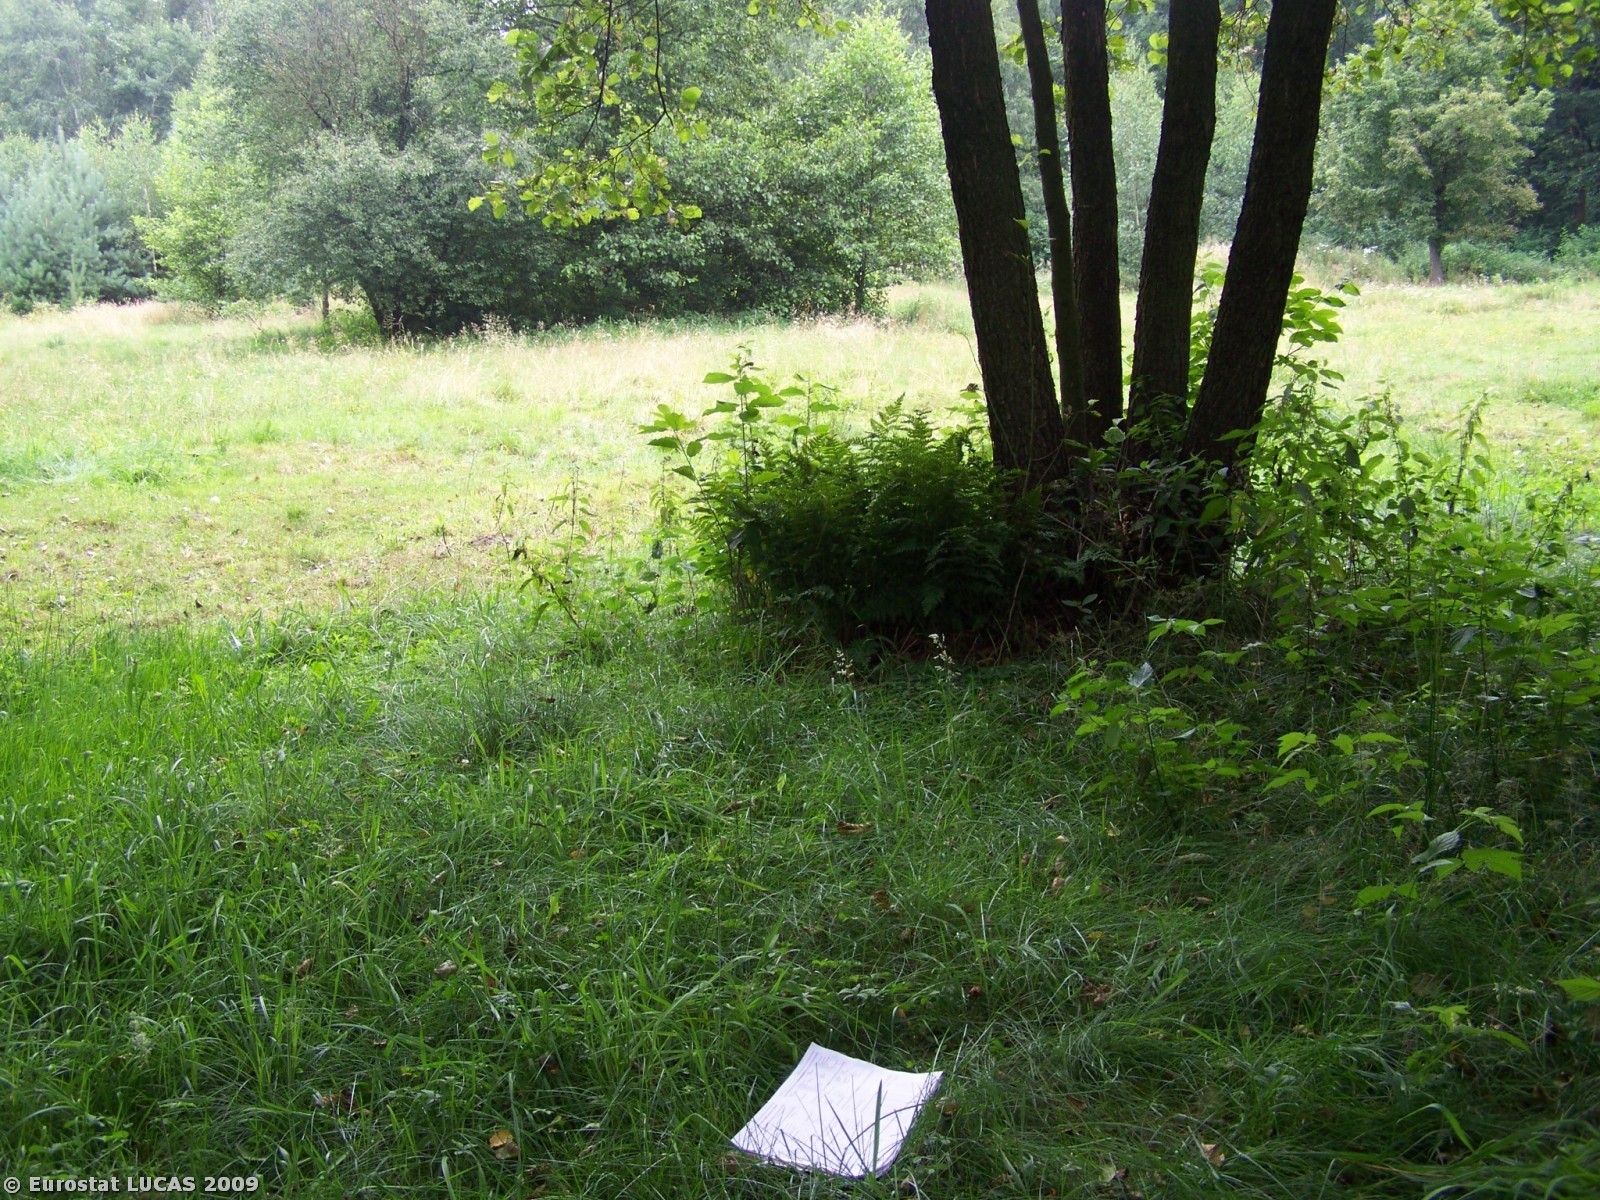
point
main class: Woodland
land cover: Broadleaved woodland
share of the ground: > 75 %
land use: Forestry
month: July
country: PL
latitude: 51.5052
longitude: 22.0606
